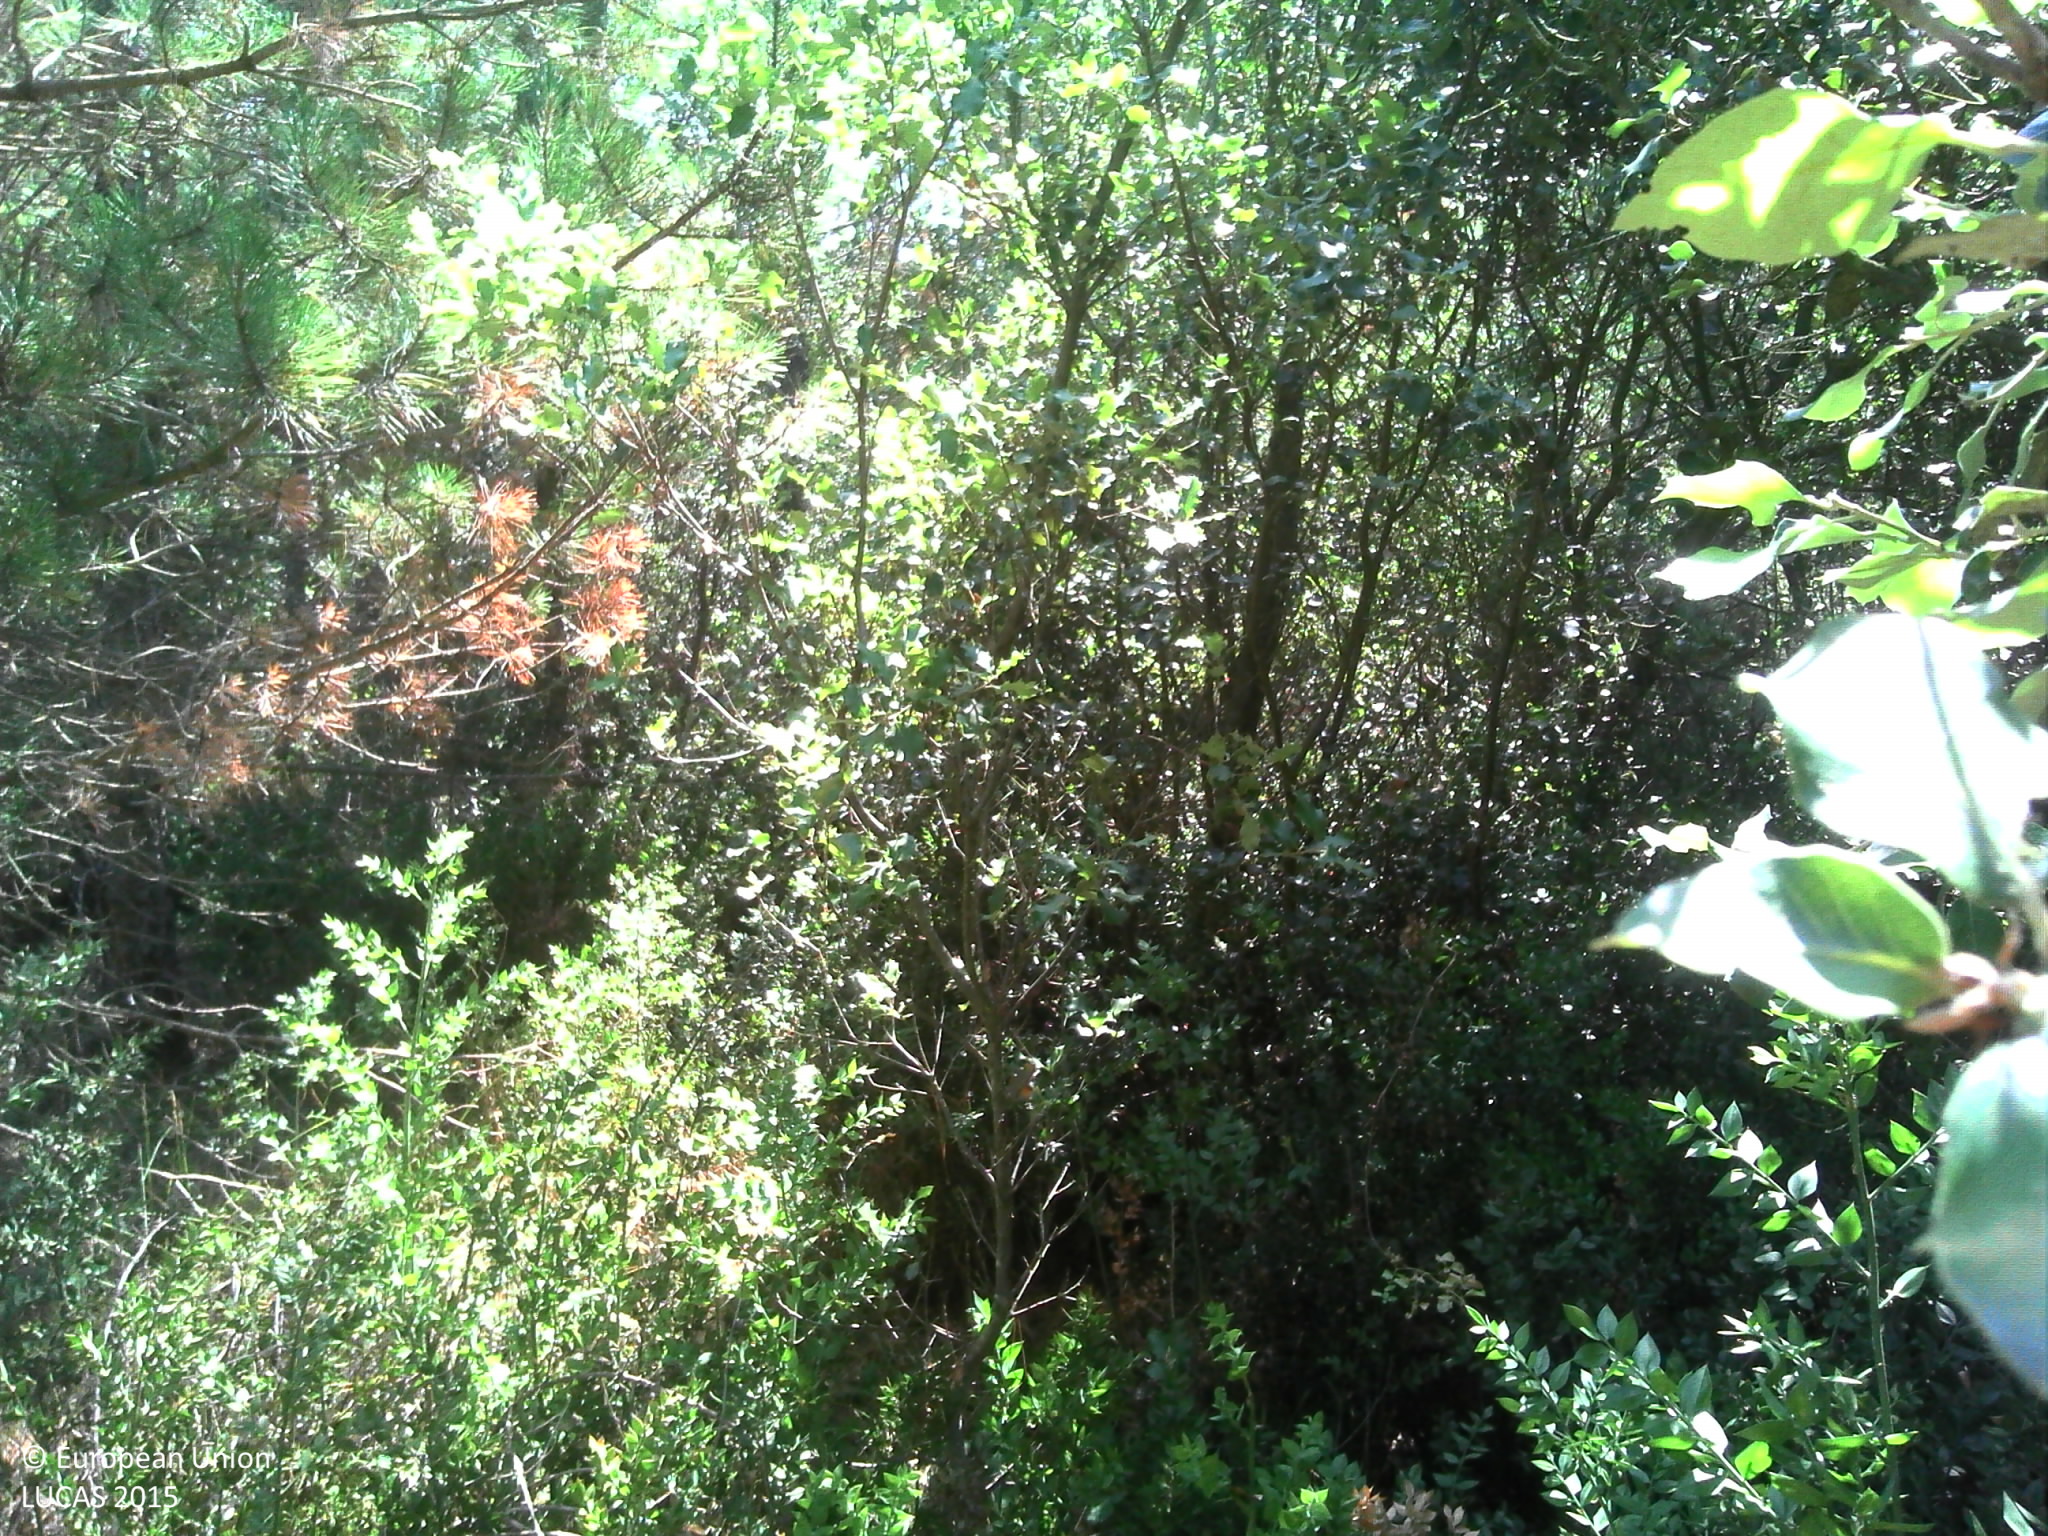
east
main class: Woodland
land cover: Pine dominated mixed woodland
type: coniferous forest of the mediterranean region
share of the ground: > 75 %
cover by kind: coniferous forest trees 50 %, broadleaved forest trees 50 %
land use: Forestry
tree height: > 5 m
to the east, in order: Pine dominated mixed woodland; Grass margins; Paved roads, cycling and walking lanes; Grass margins; Electric lines; Pine dominated mixed woodland
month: July
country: FR
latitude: 44.3120
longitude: 4.8298
